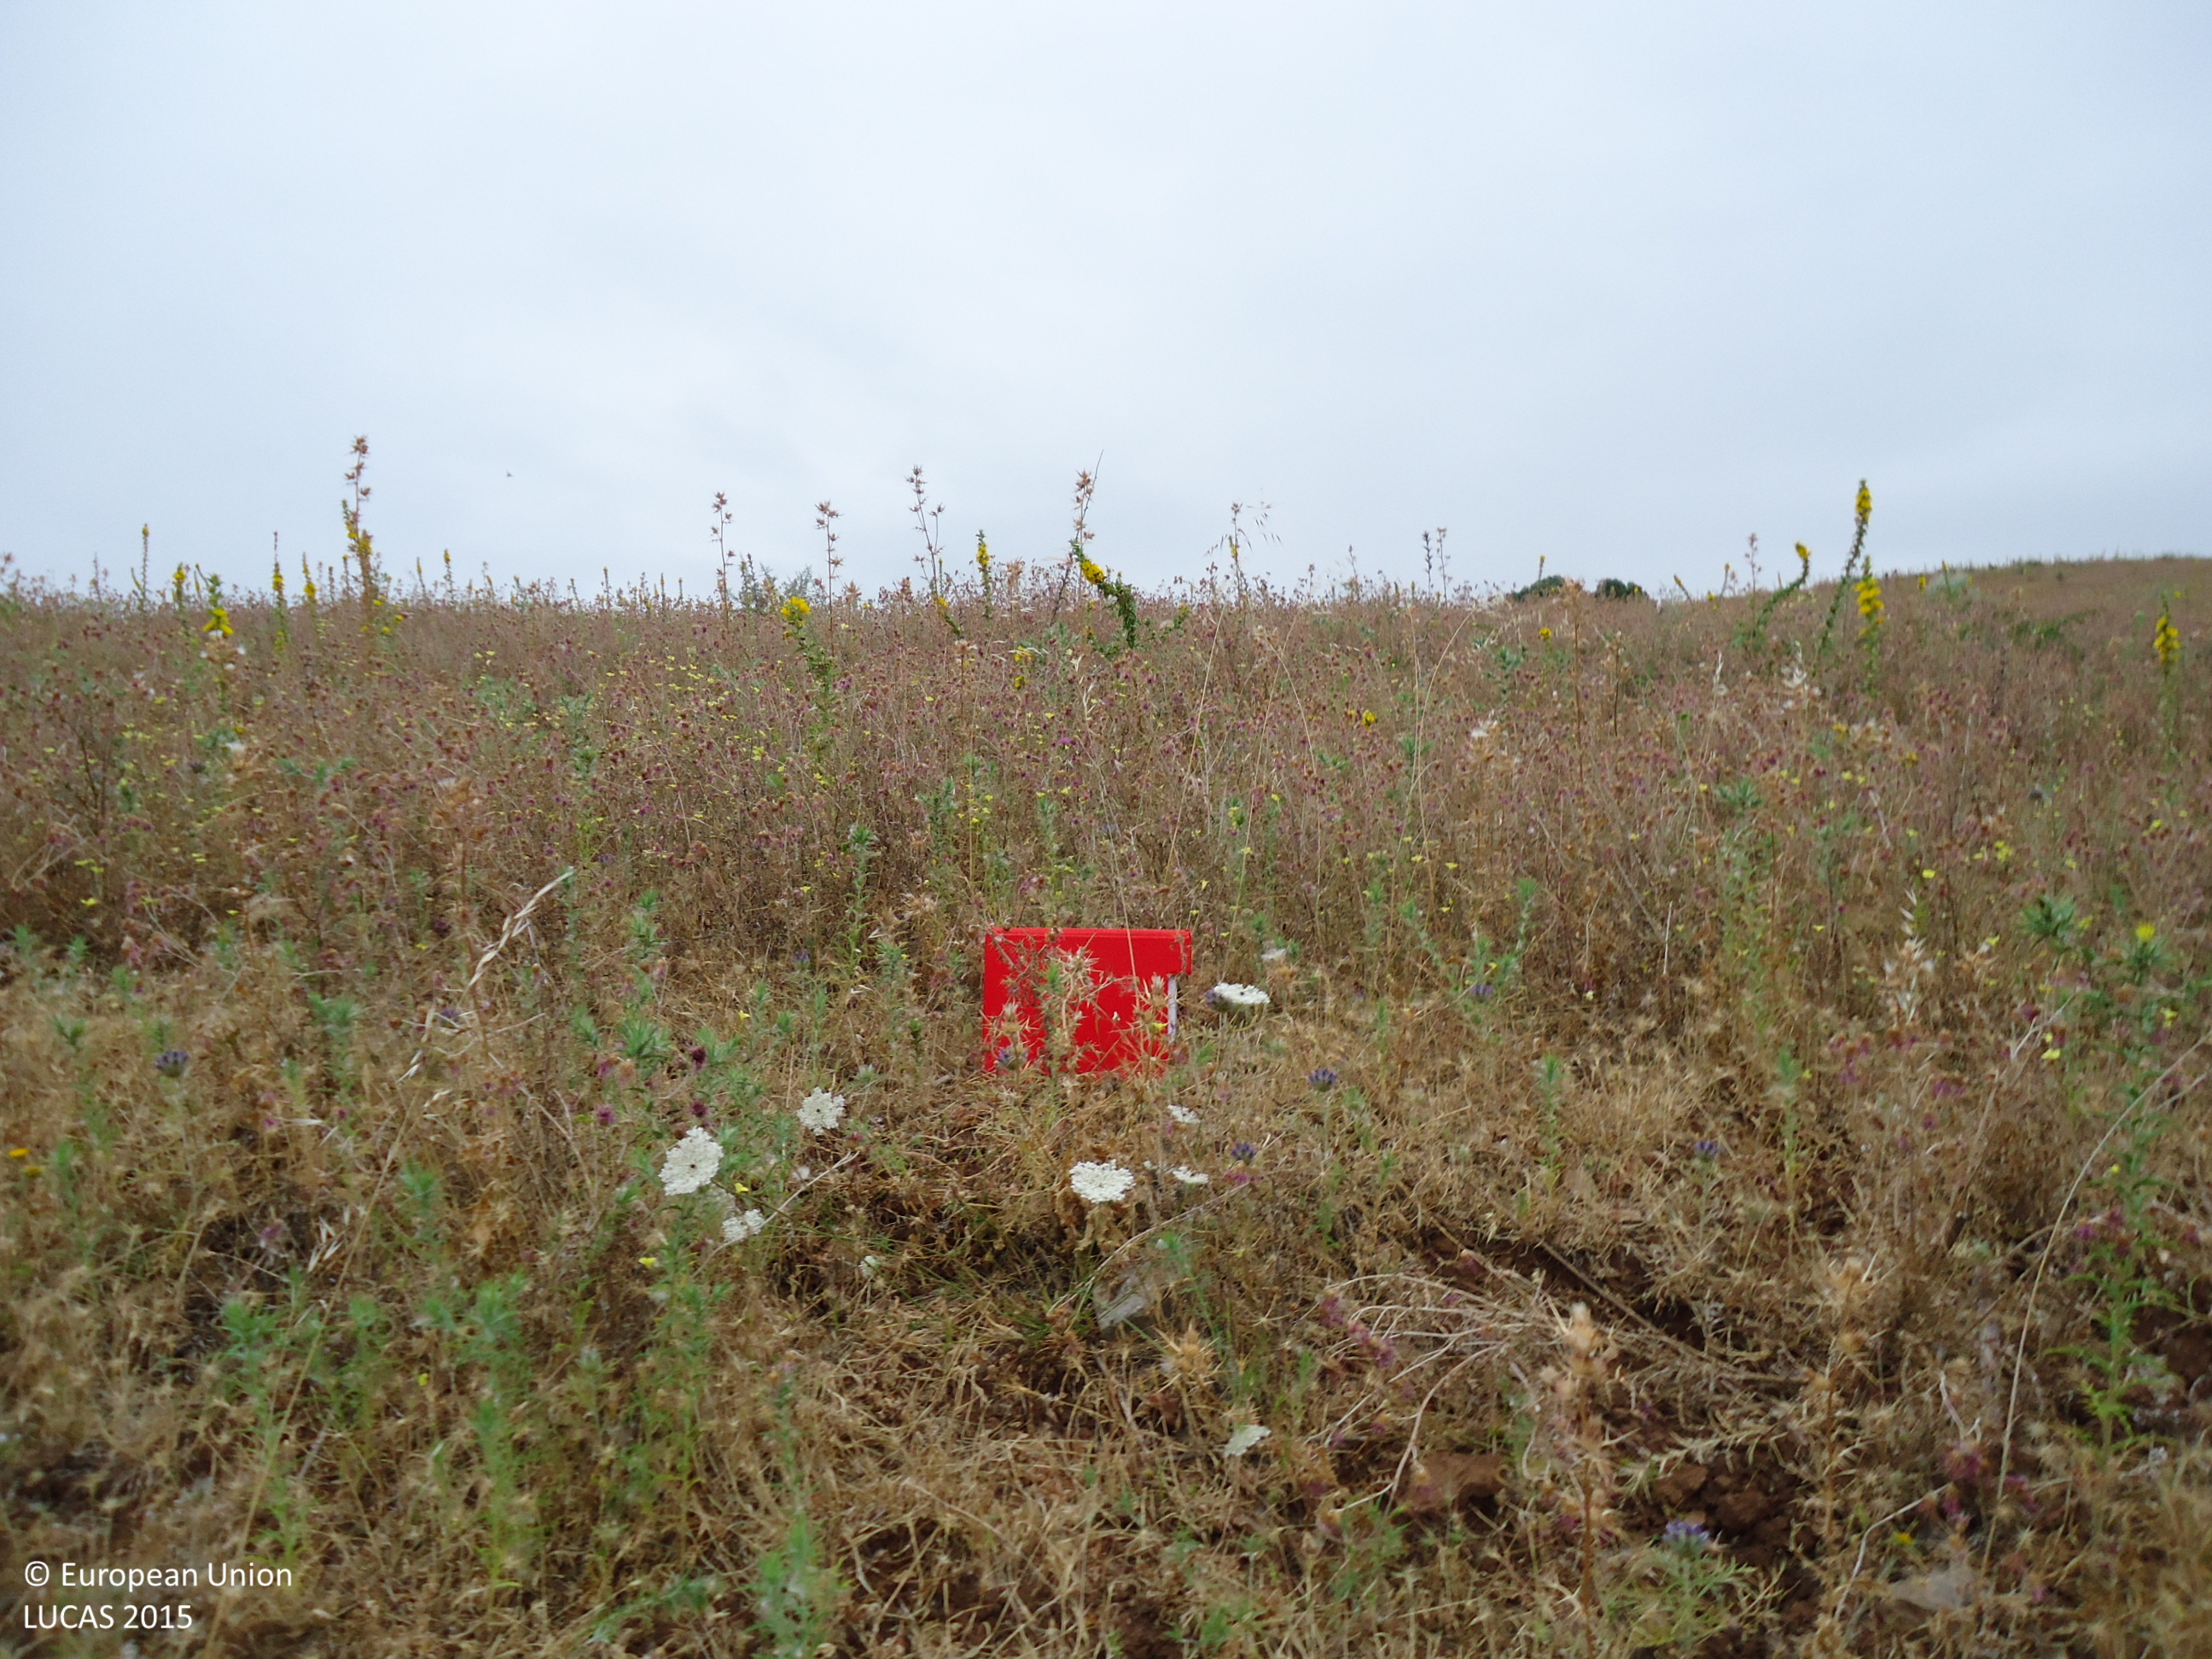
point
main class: Grassland
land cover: Spontaneously vegetated surfaces
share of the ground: > 75 %
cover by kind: herbaceous plants 100 %
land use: Agriculture (excluding fallow land and kitchen gardens)
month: June
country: ES
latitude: 36.4368
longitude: -5.3568
